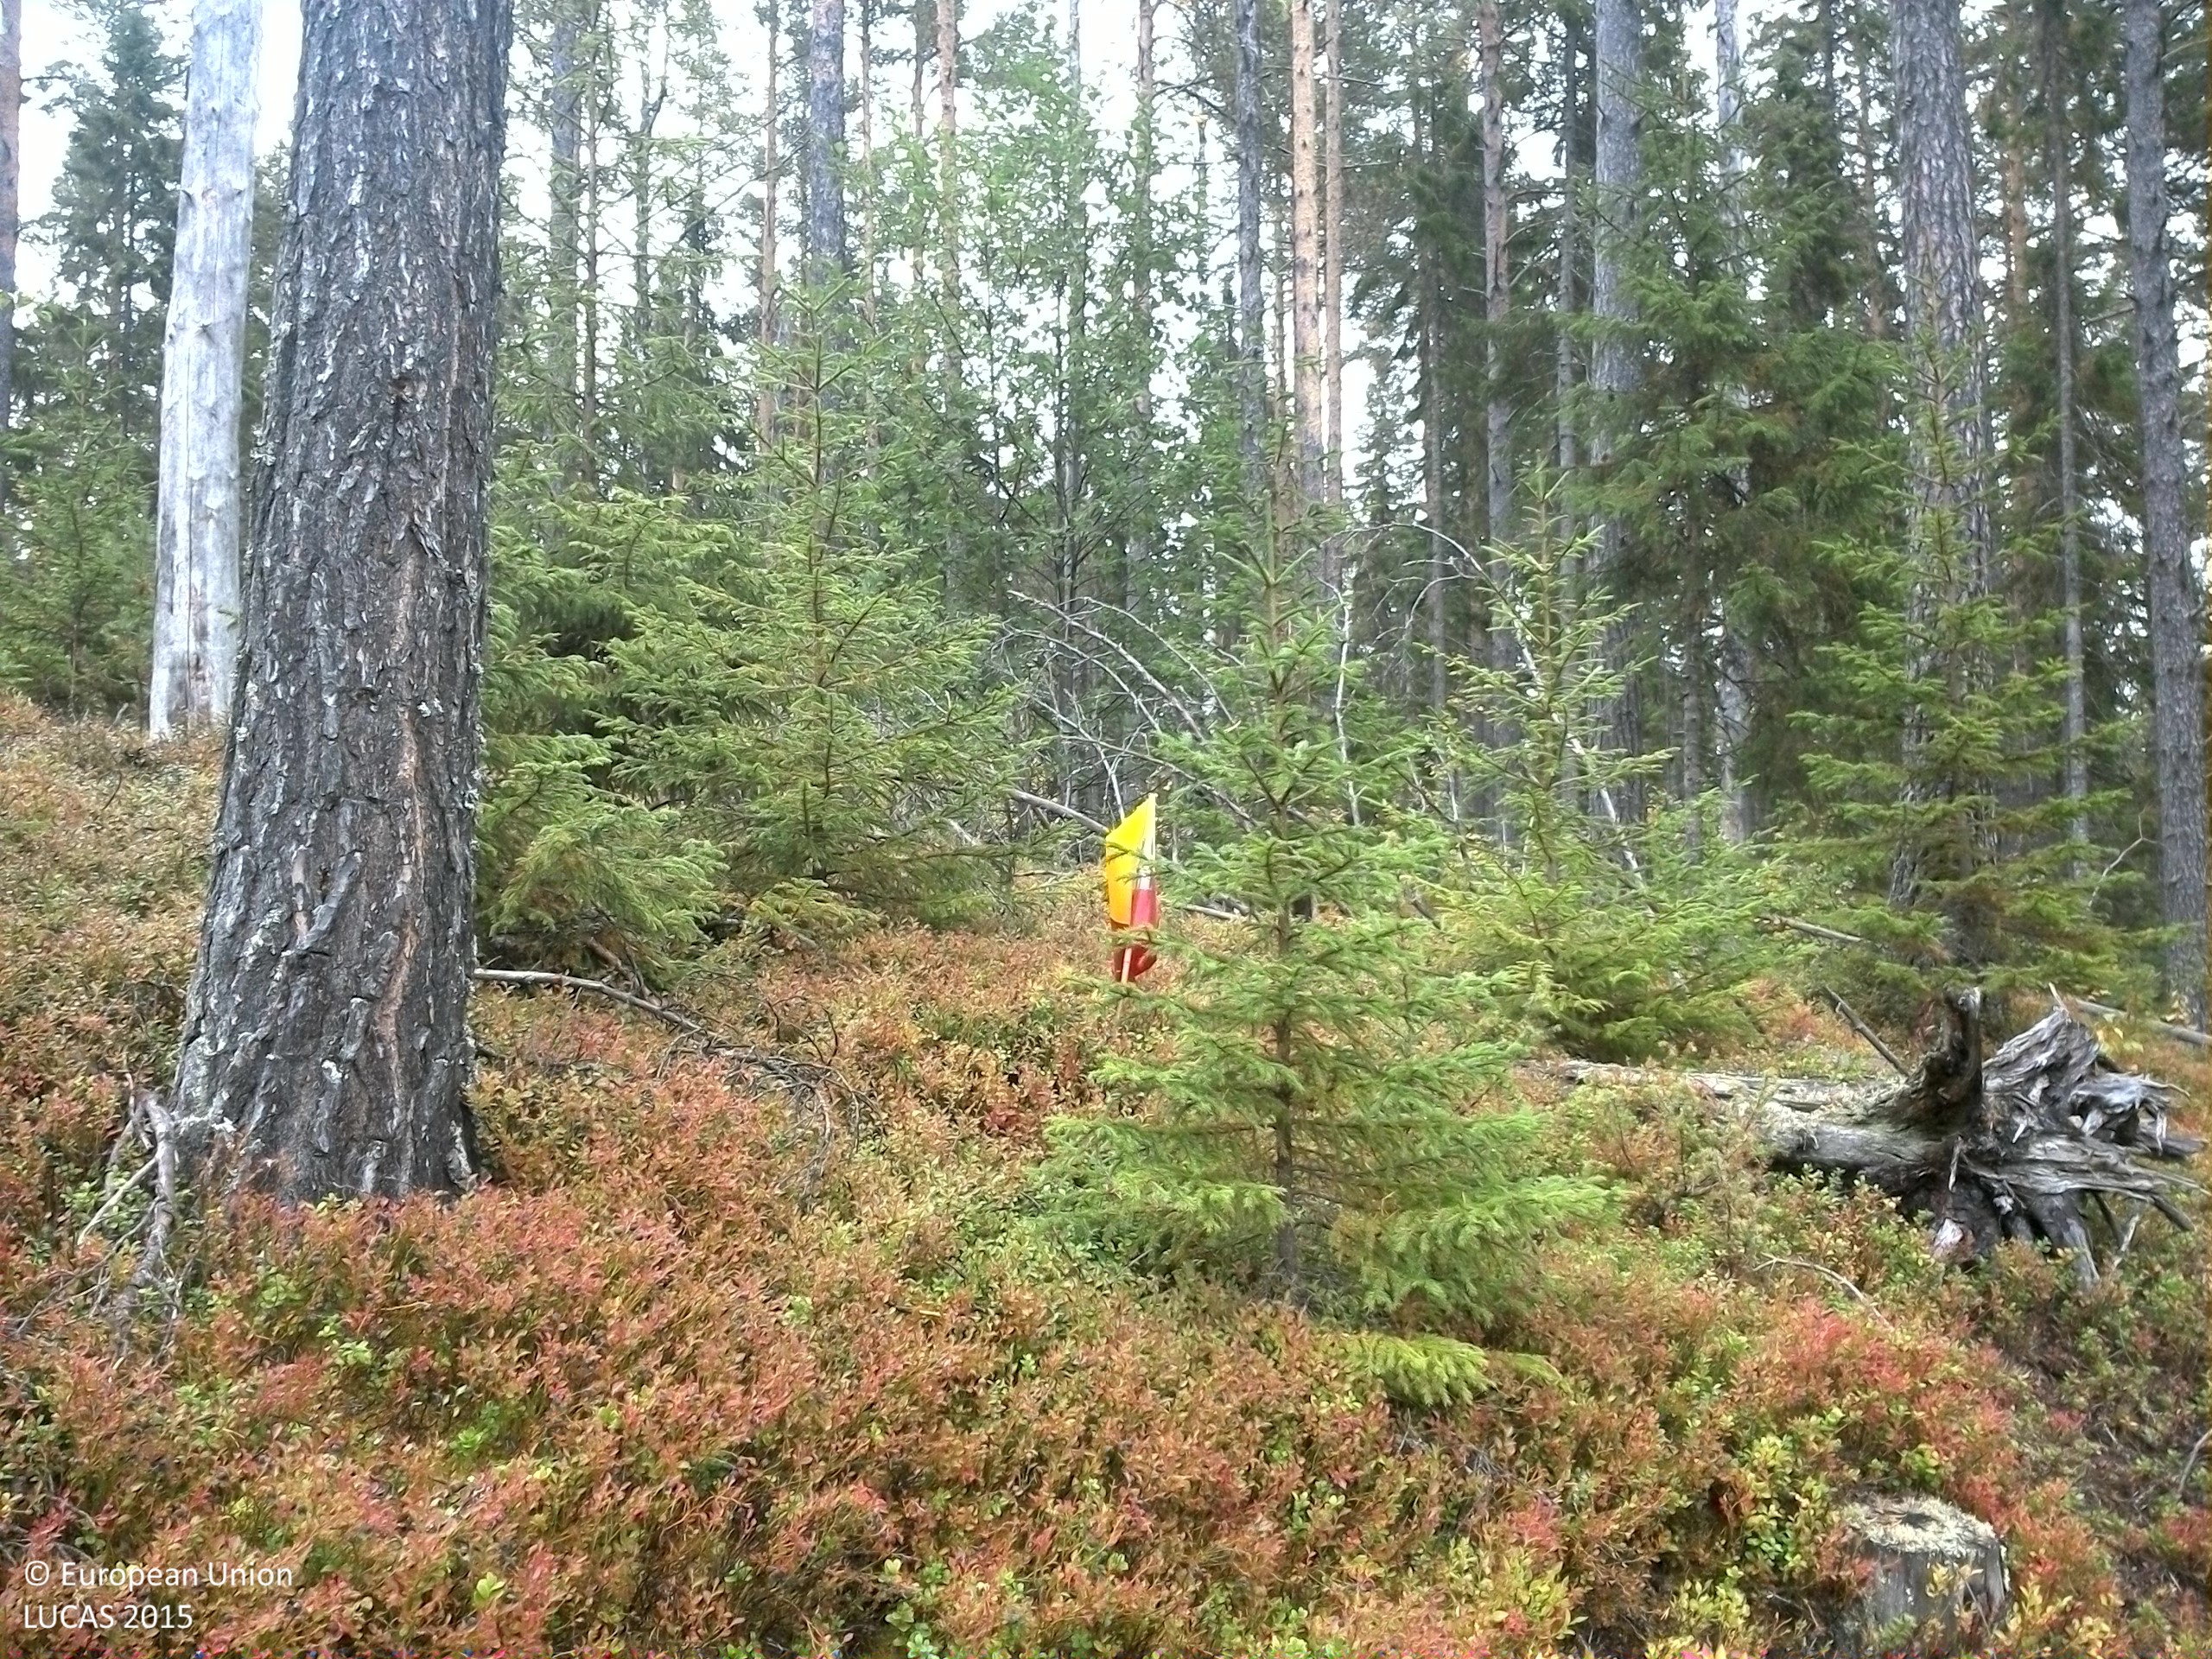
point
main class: Woodland
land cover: Pine dominated coniferous woodland
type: boreal forest
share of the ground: 50 - 75 %
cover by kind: coniferous forest trees 45 %, shrubs 35 %, broadleaved forest trees 10 %, lichens and mosses 10 %
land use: Forestry
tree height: > 5 m
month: September
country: SE
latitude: 63.6785
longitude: 16.2192
